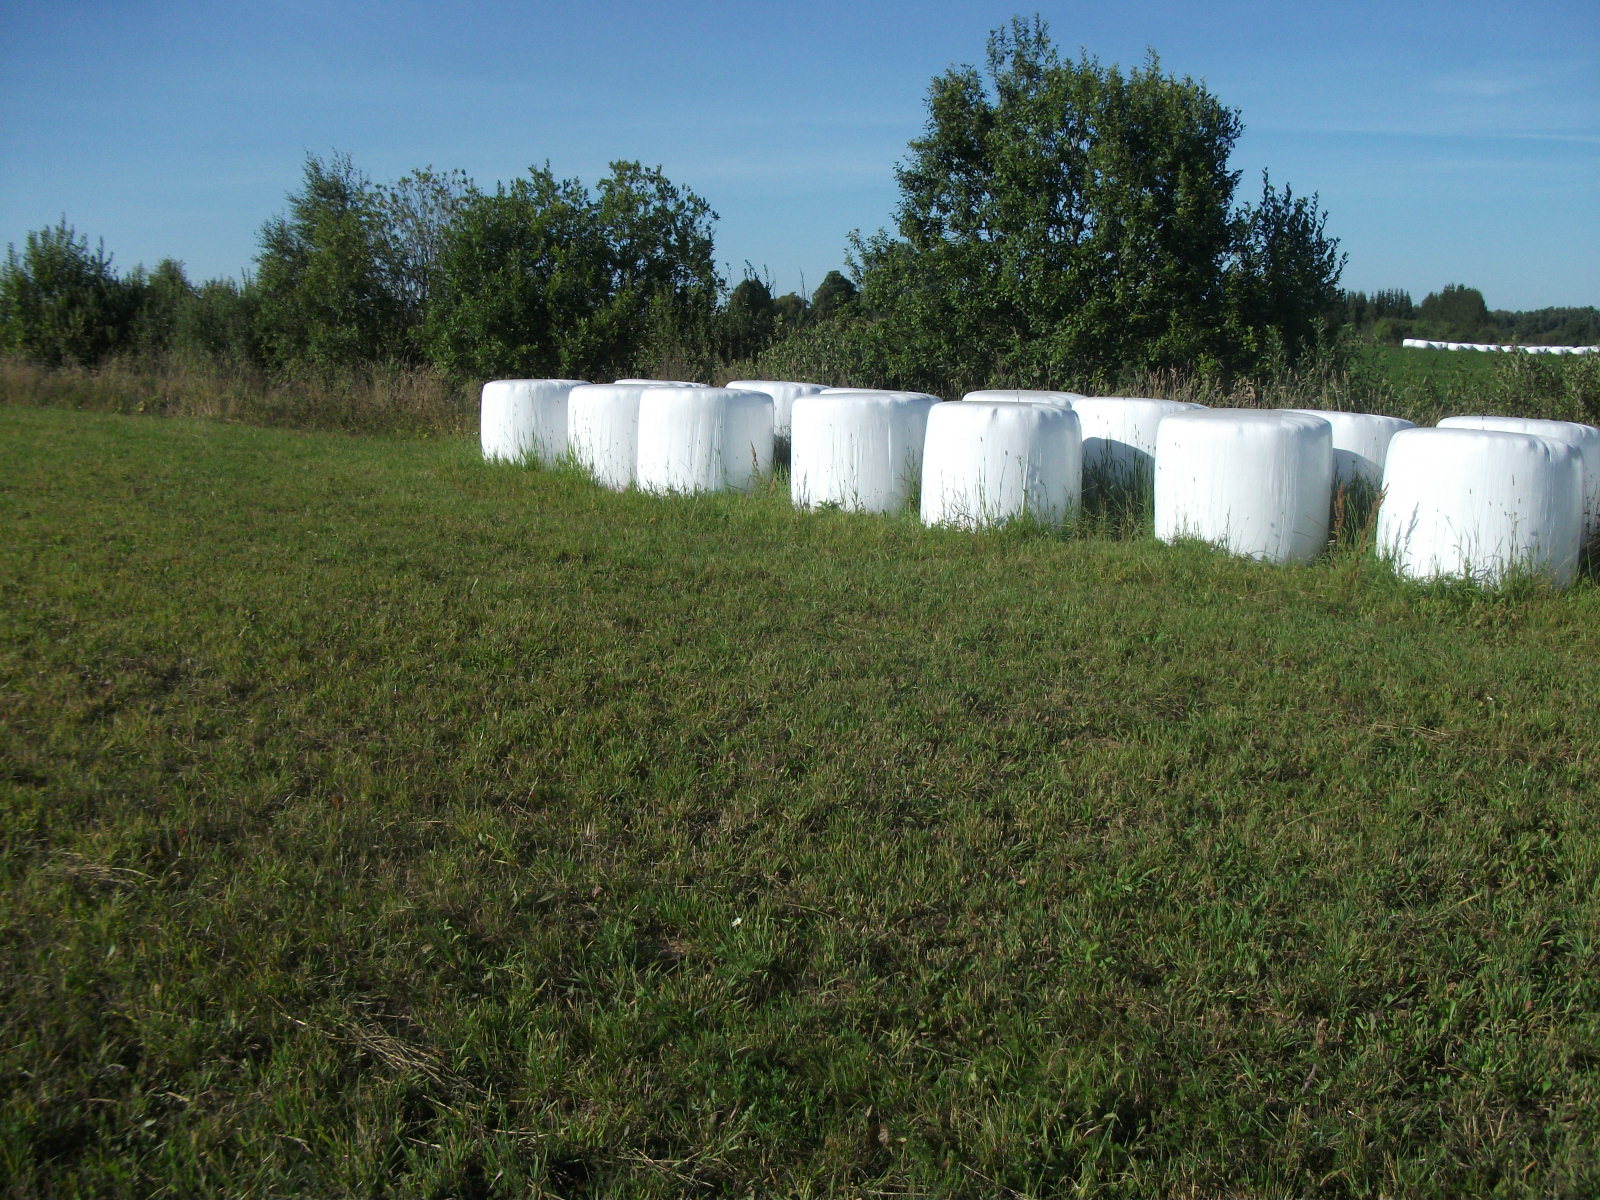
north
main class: Grassland
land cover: Grassland without tree/shrub cover
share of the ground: > 75 %
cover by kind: herbaceous plants 100 %
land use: Agriculture (excluding fallow land and kitchen gardens)
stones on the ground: < 10 %
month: August
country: LV
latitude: 56.3559
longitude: 26.2442
